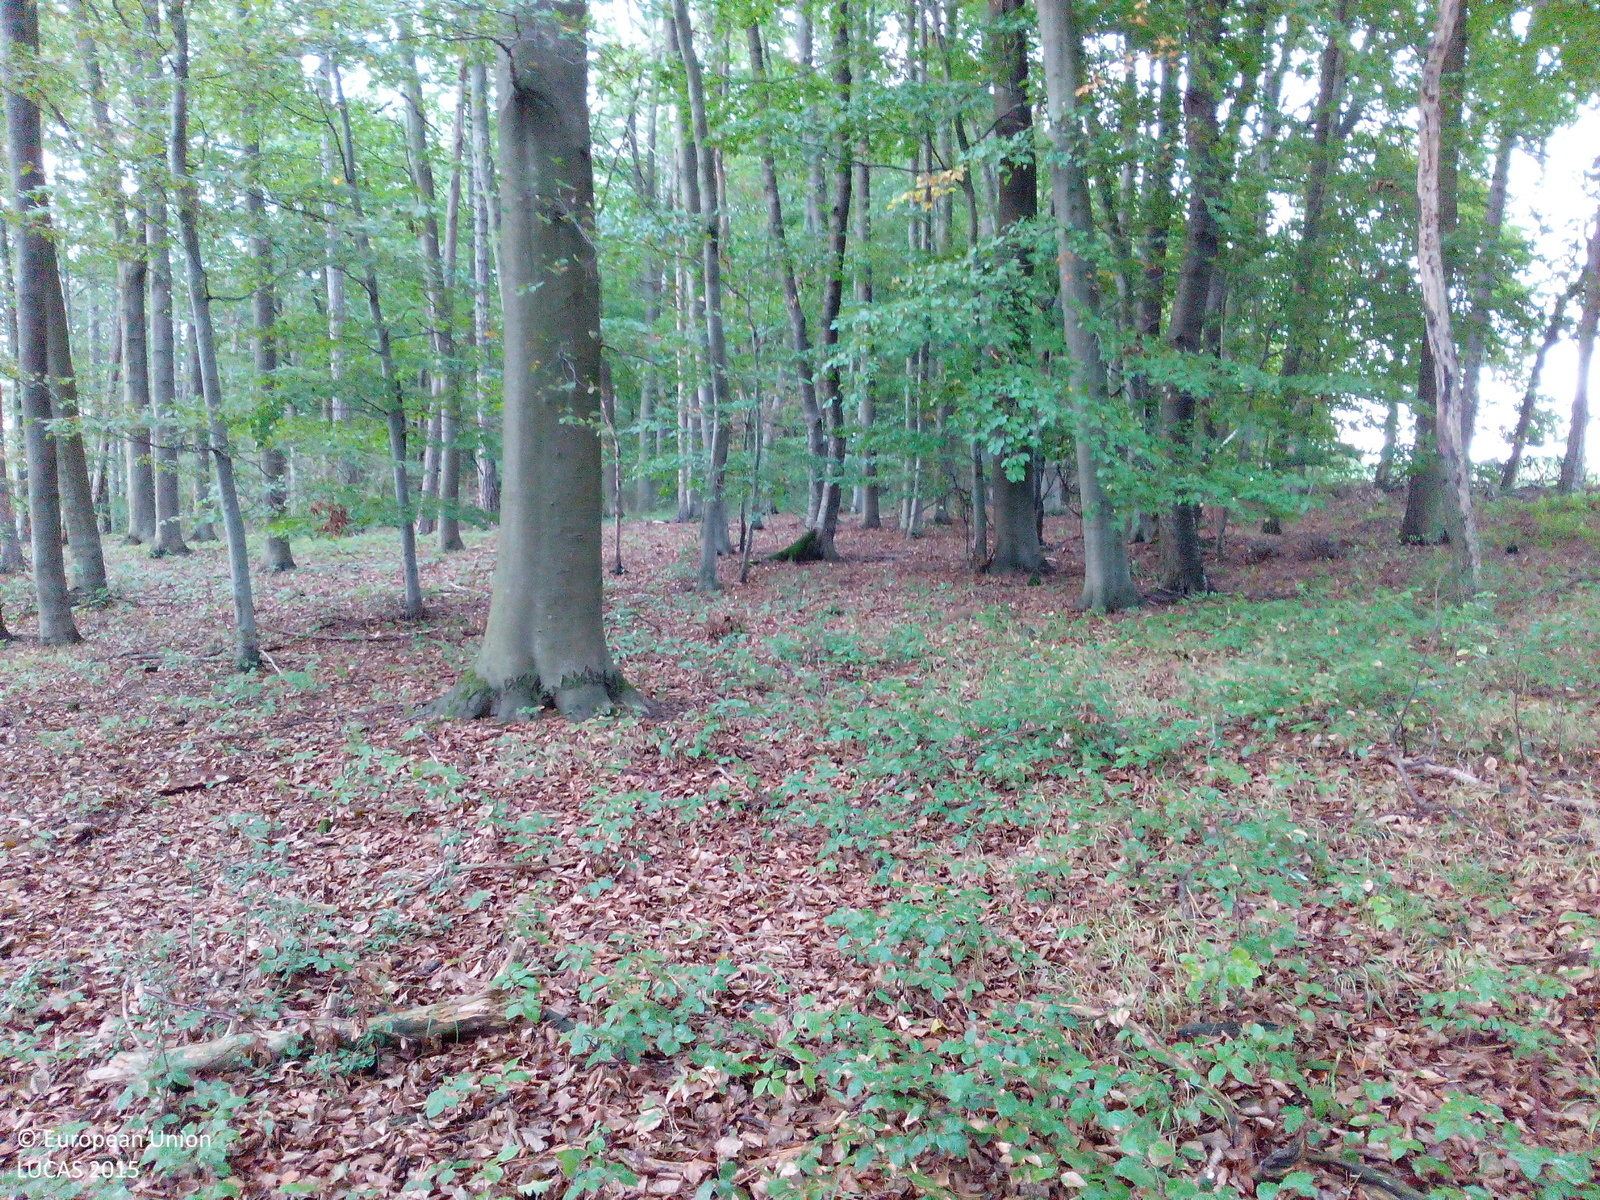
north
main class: Woodland
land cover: Pine dominated mixed woodland
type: hemiboreal forest and nemoral coniferous forest and mixed broadleaved-coniferous forest
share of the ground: > 75 %
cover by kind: broadleaved forest trees 45 %, coniferous forest trees 35 %, herbaceous plants 10 %, unconsolidated bare surface 10 %
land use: Forestry
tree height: > 5 m
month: September
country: DE
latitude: 49.9324
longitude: 9.9025
